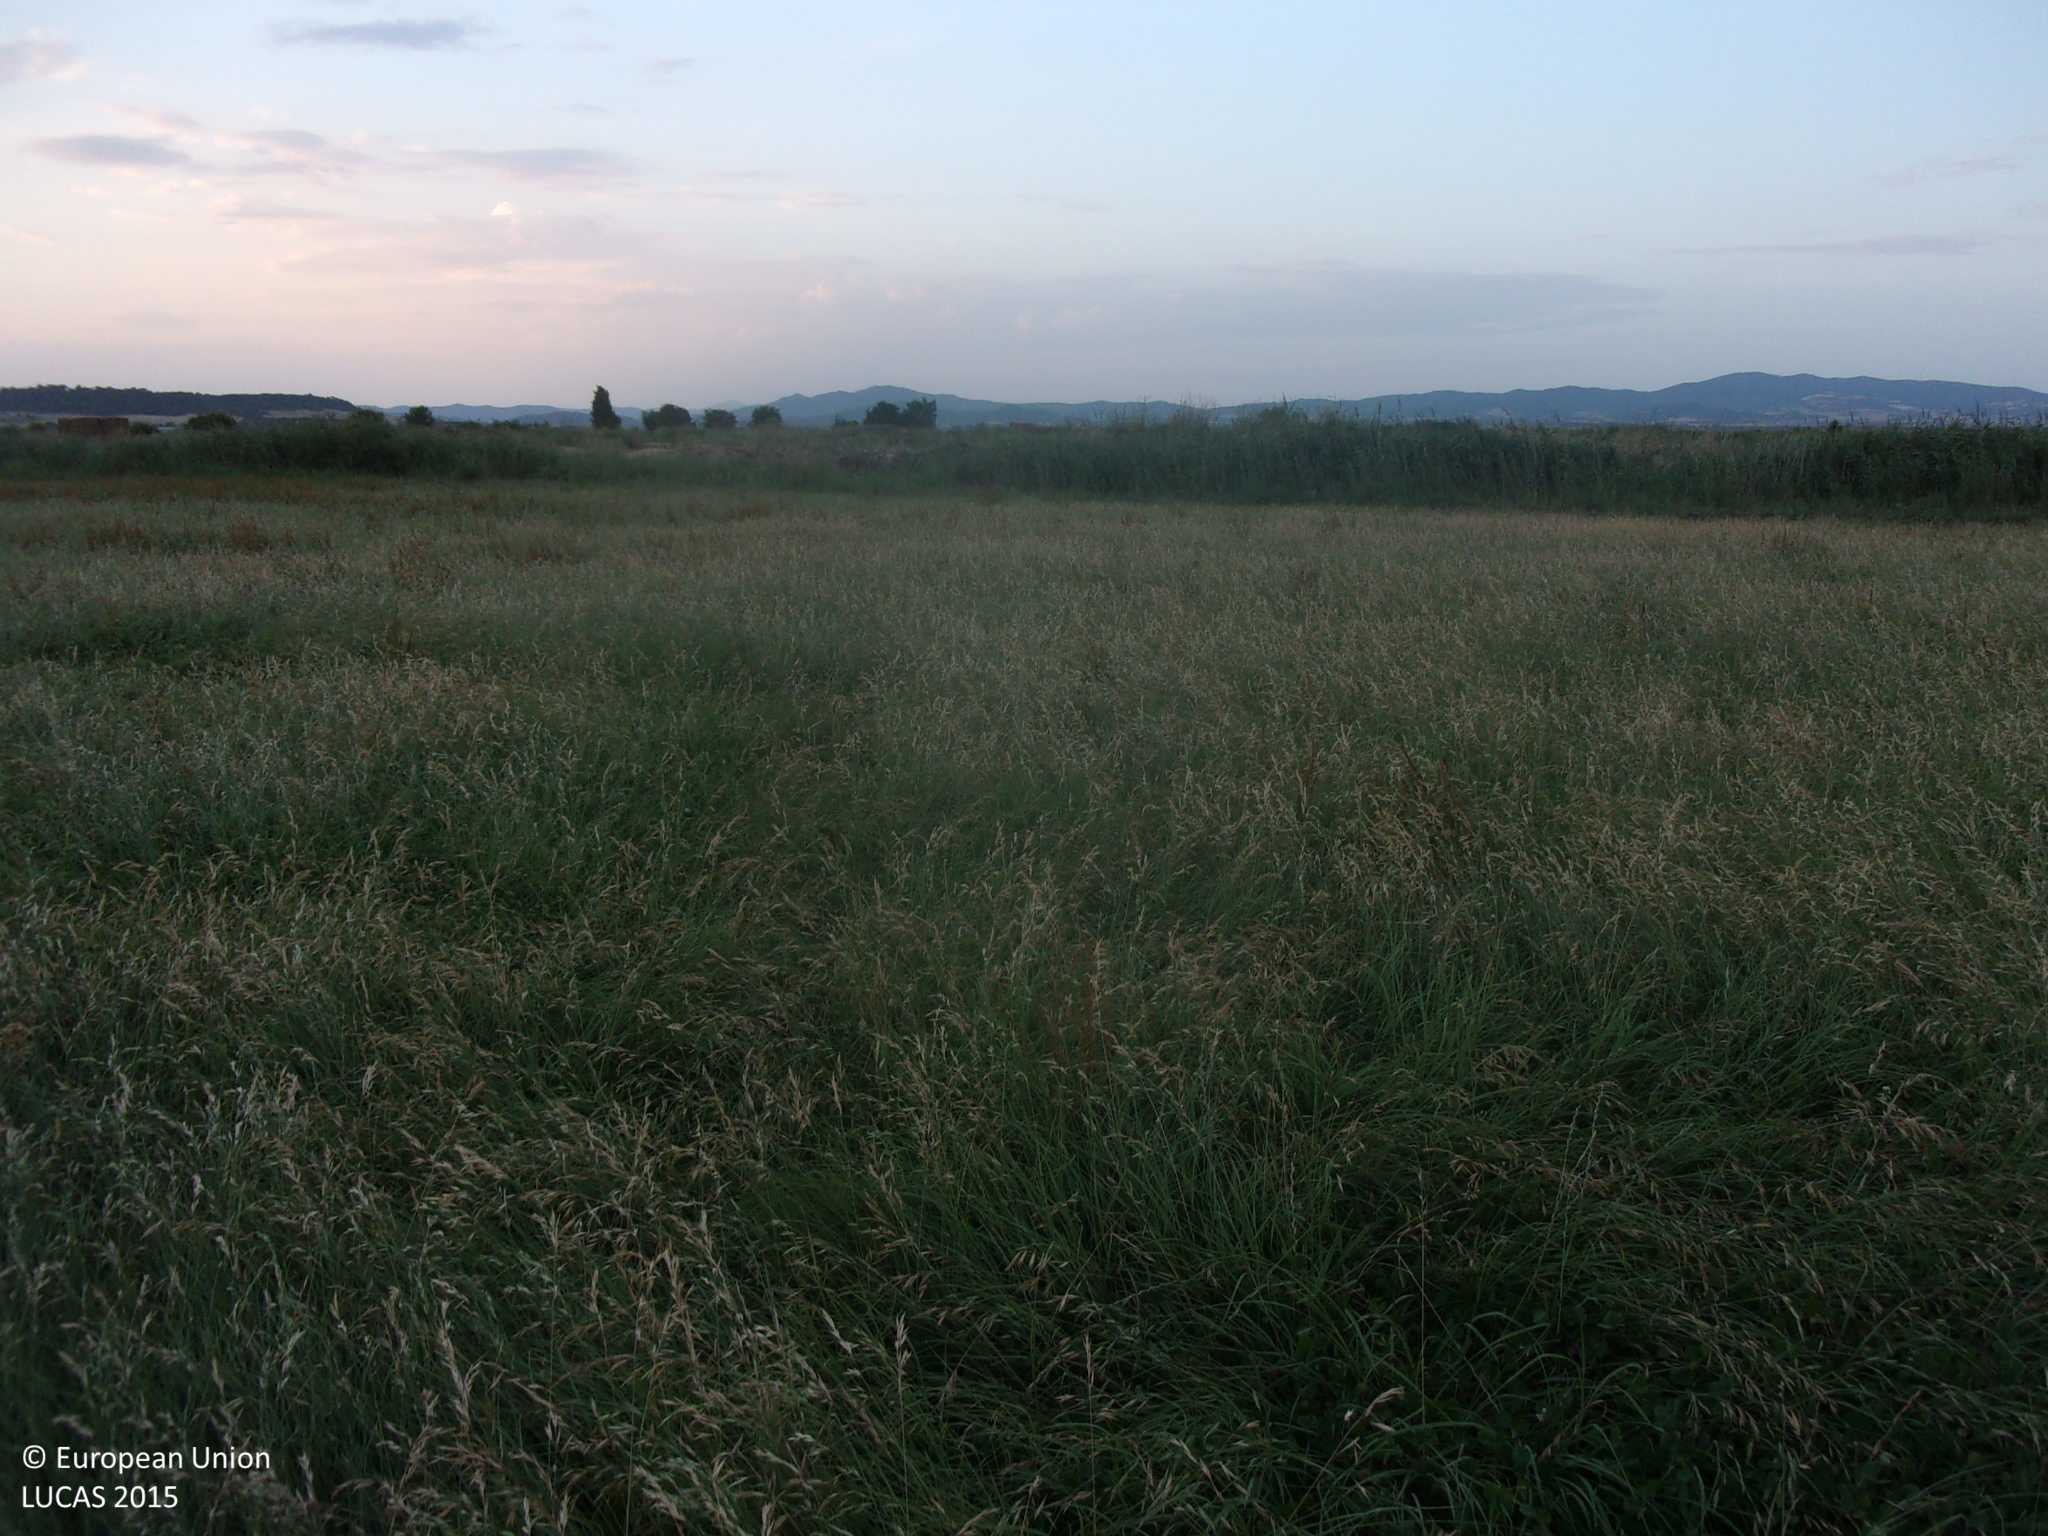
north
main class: Cropland
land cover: Temporary grasslands
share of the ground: > 75 %
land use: Agriculture (excluding fallow land and kitchen gardens)
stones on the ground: < 10 %
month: August
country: ES
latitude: 42.3562
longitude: -1.3840
